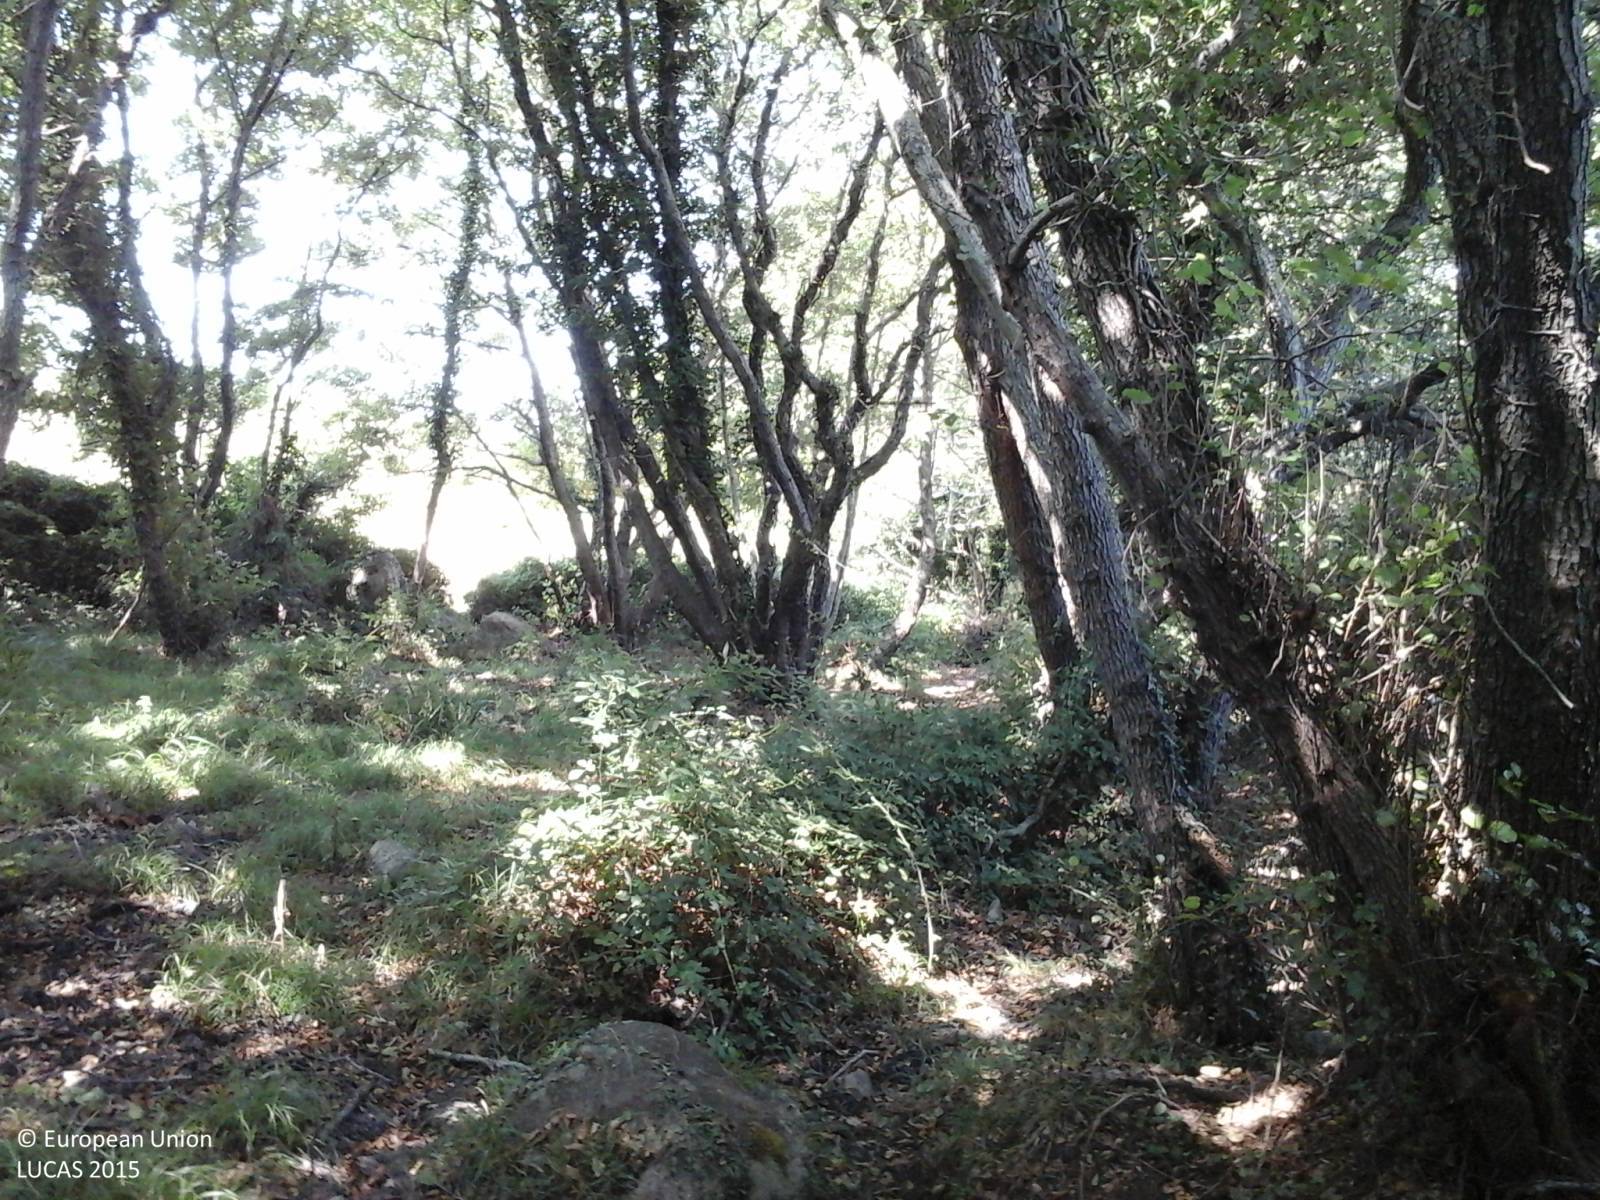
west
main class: Woodland
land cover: Broadleaved woodland
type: acidophilous oak and oak-birch forest
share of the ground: 10 - 25 %
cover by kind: unconsolidated bare surface 50 %, herbaceous plants 25 %, shrubs 15 %, broadleaved forest trees 10 %
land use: Semi-natural and natural areas not in use
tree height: > 5 m
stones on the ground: < 10 %
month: August
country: IT
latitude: 40.9876
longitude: 9.1600
